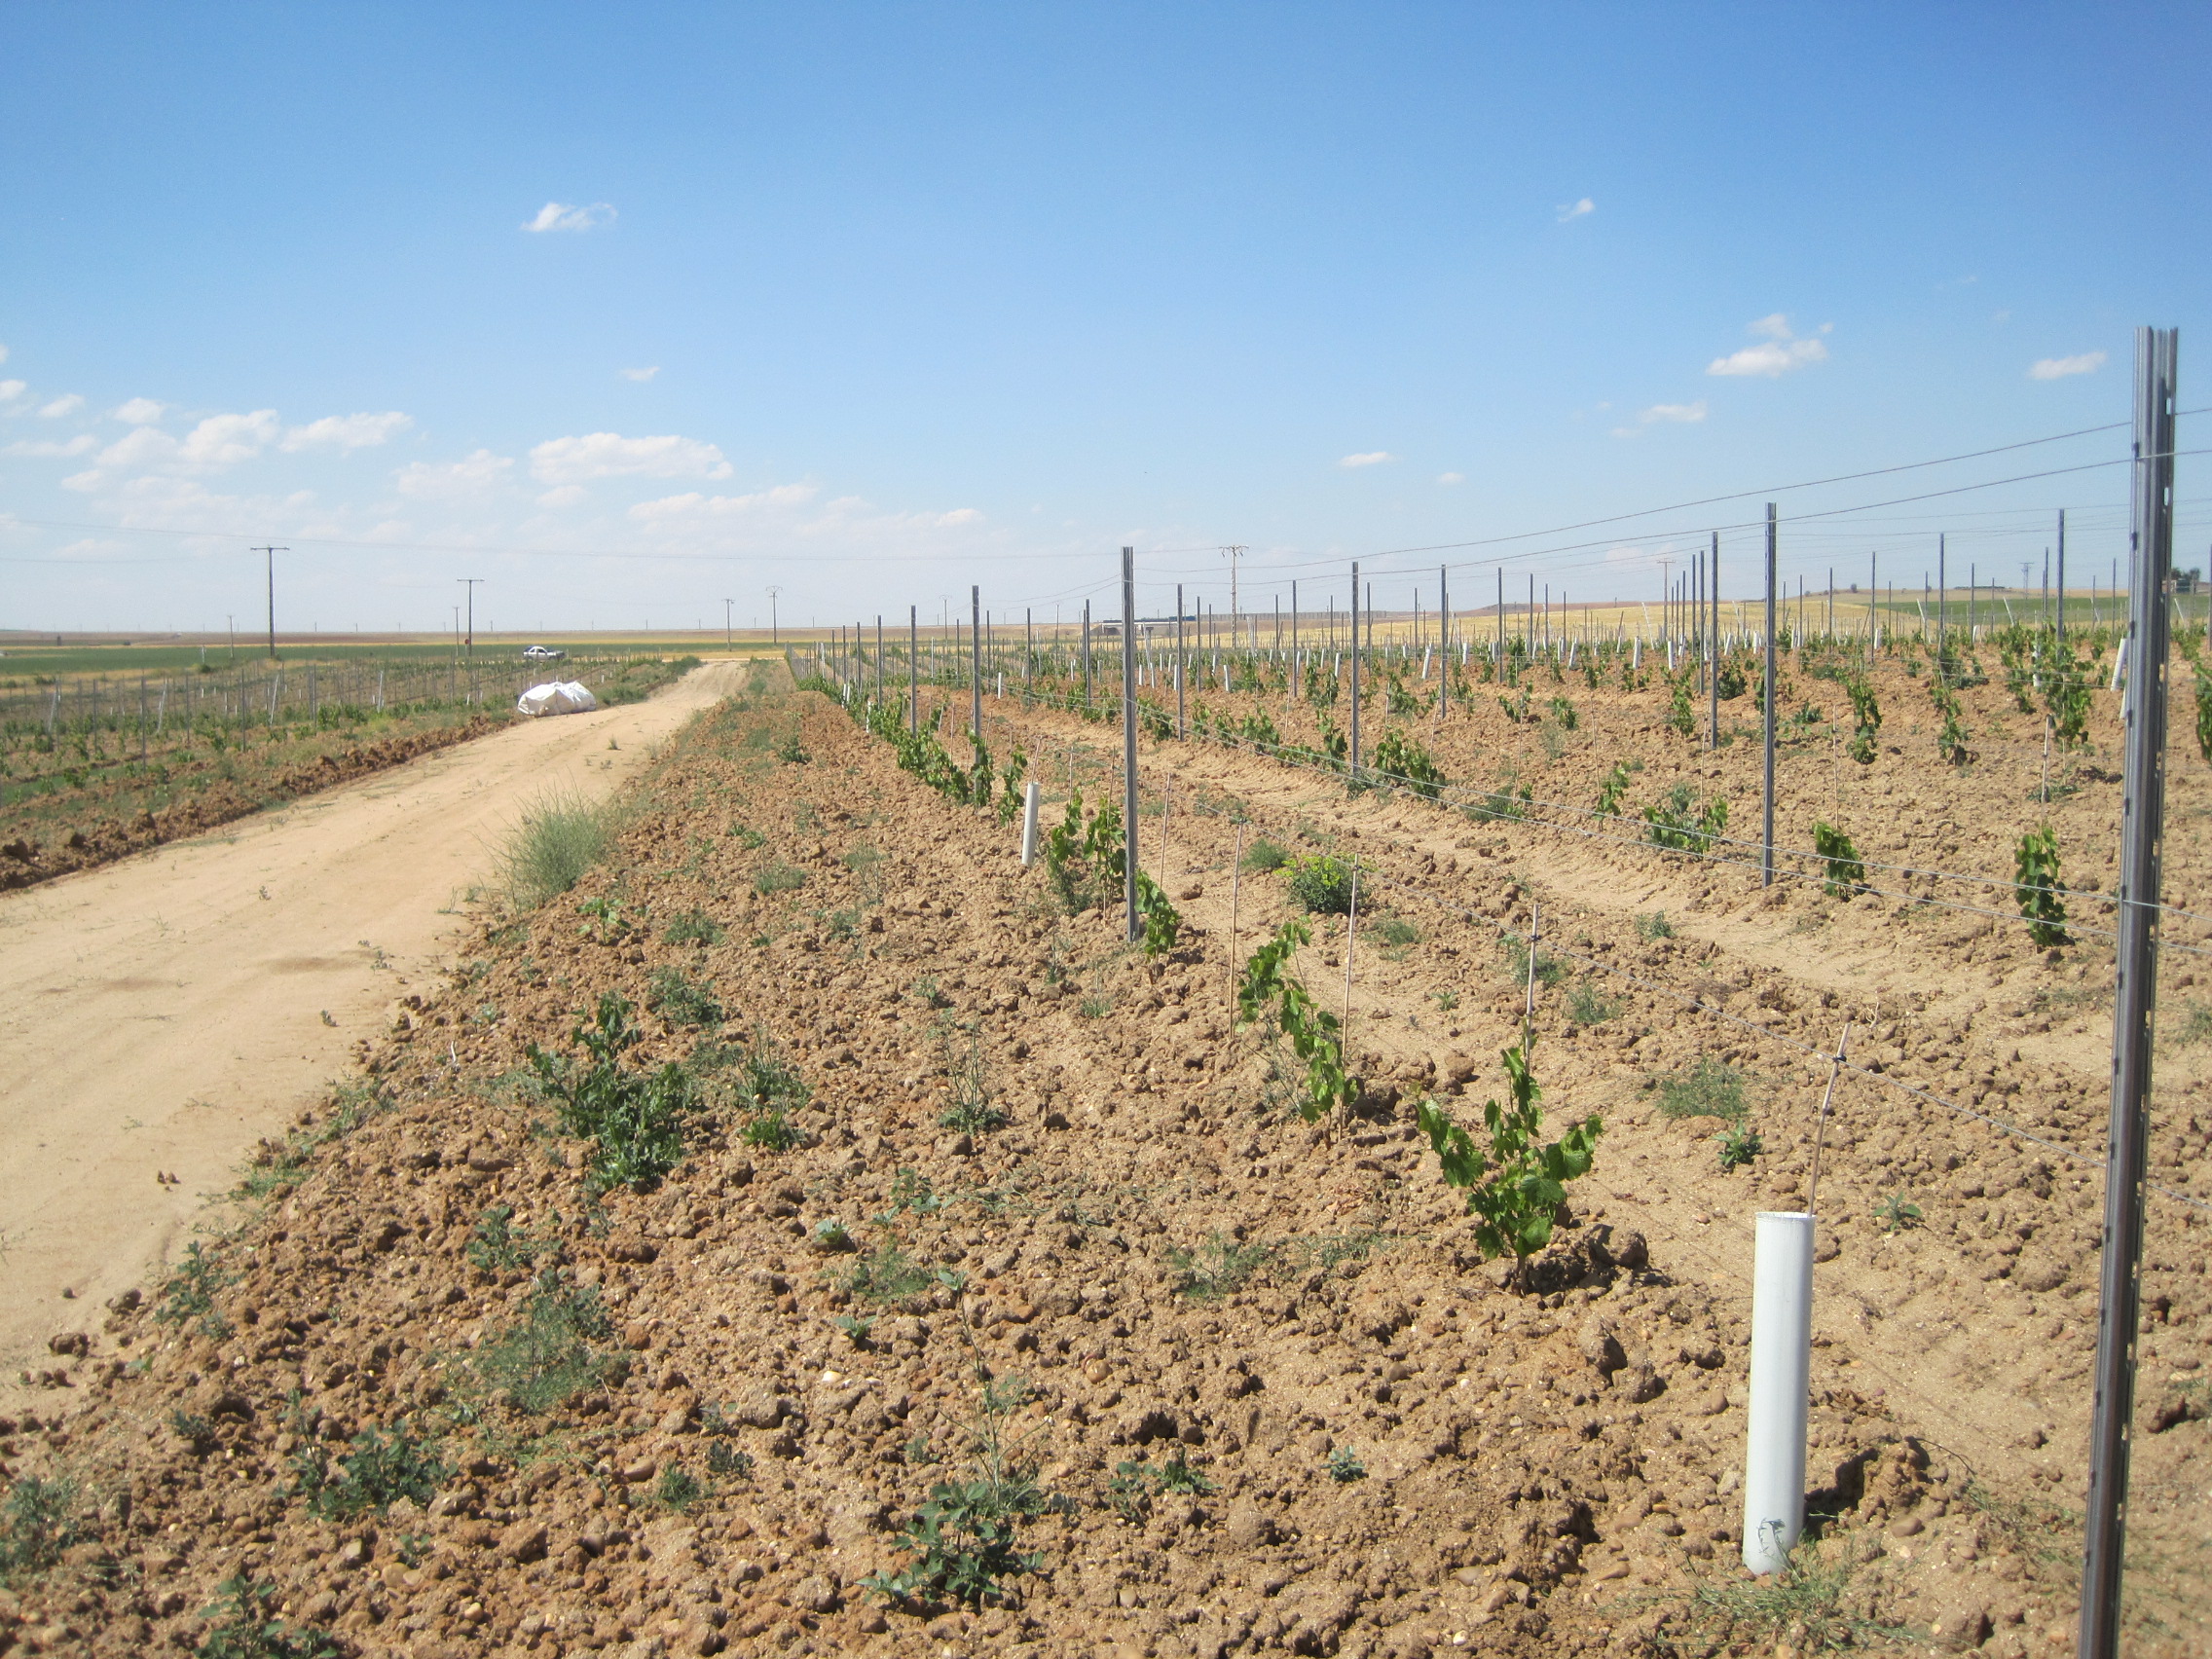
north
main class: Cropland
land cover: Vineyards
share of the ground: 25 - 50 %
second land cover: Other bare soil
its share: > 75 %
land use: Agriculture (excluding fallow land and kitchen gardens)
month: May
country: ES
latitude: 41.3360
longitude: -5.0676
